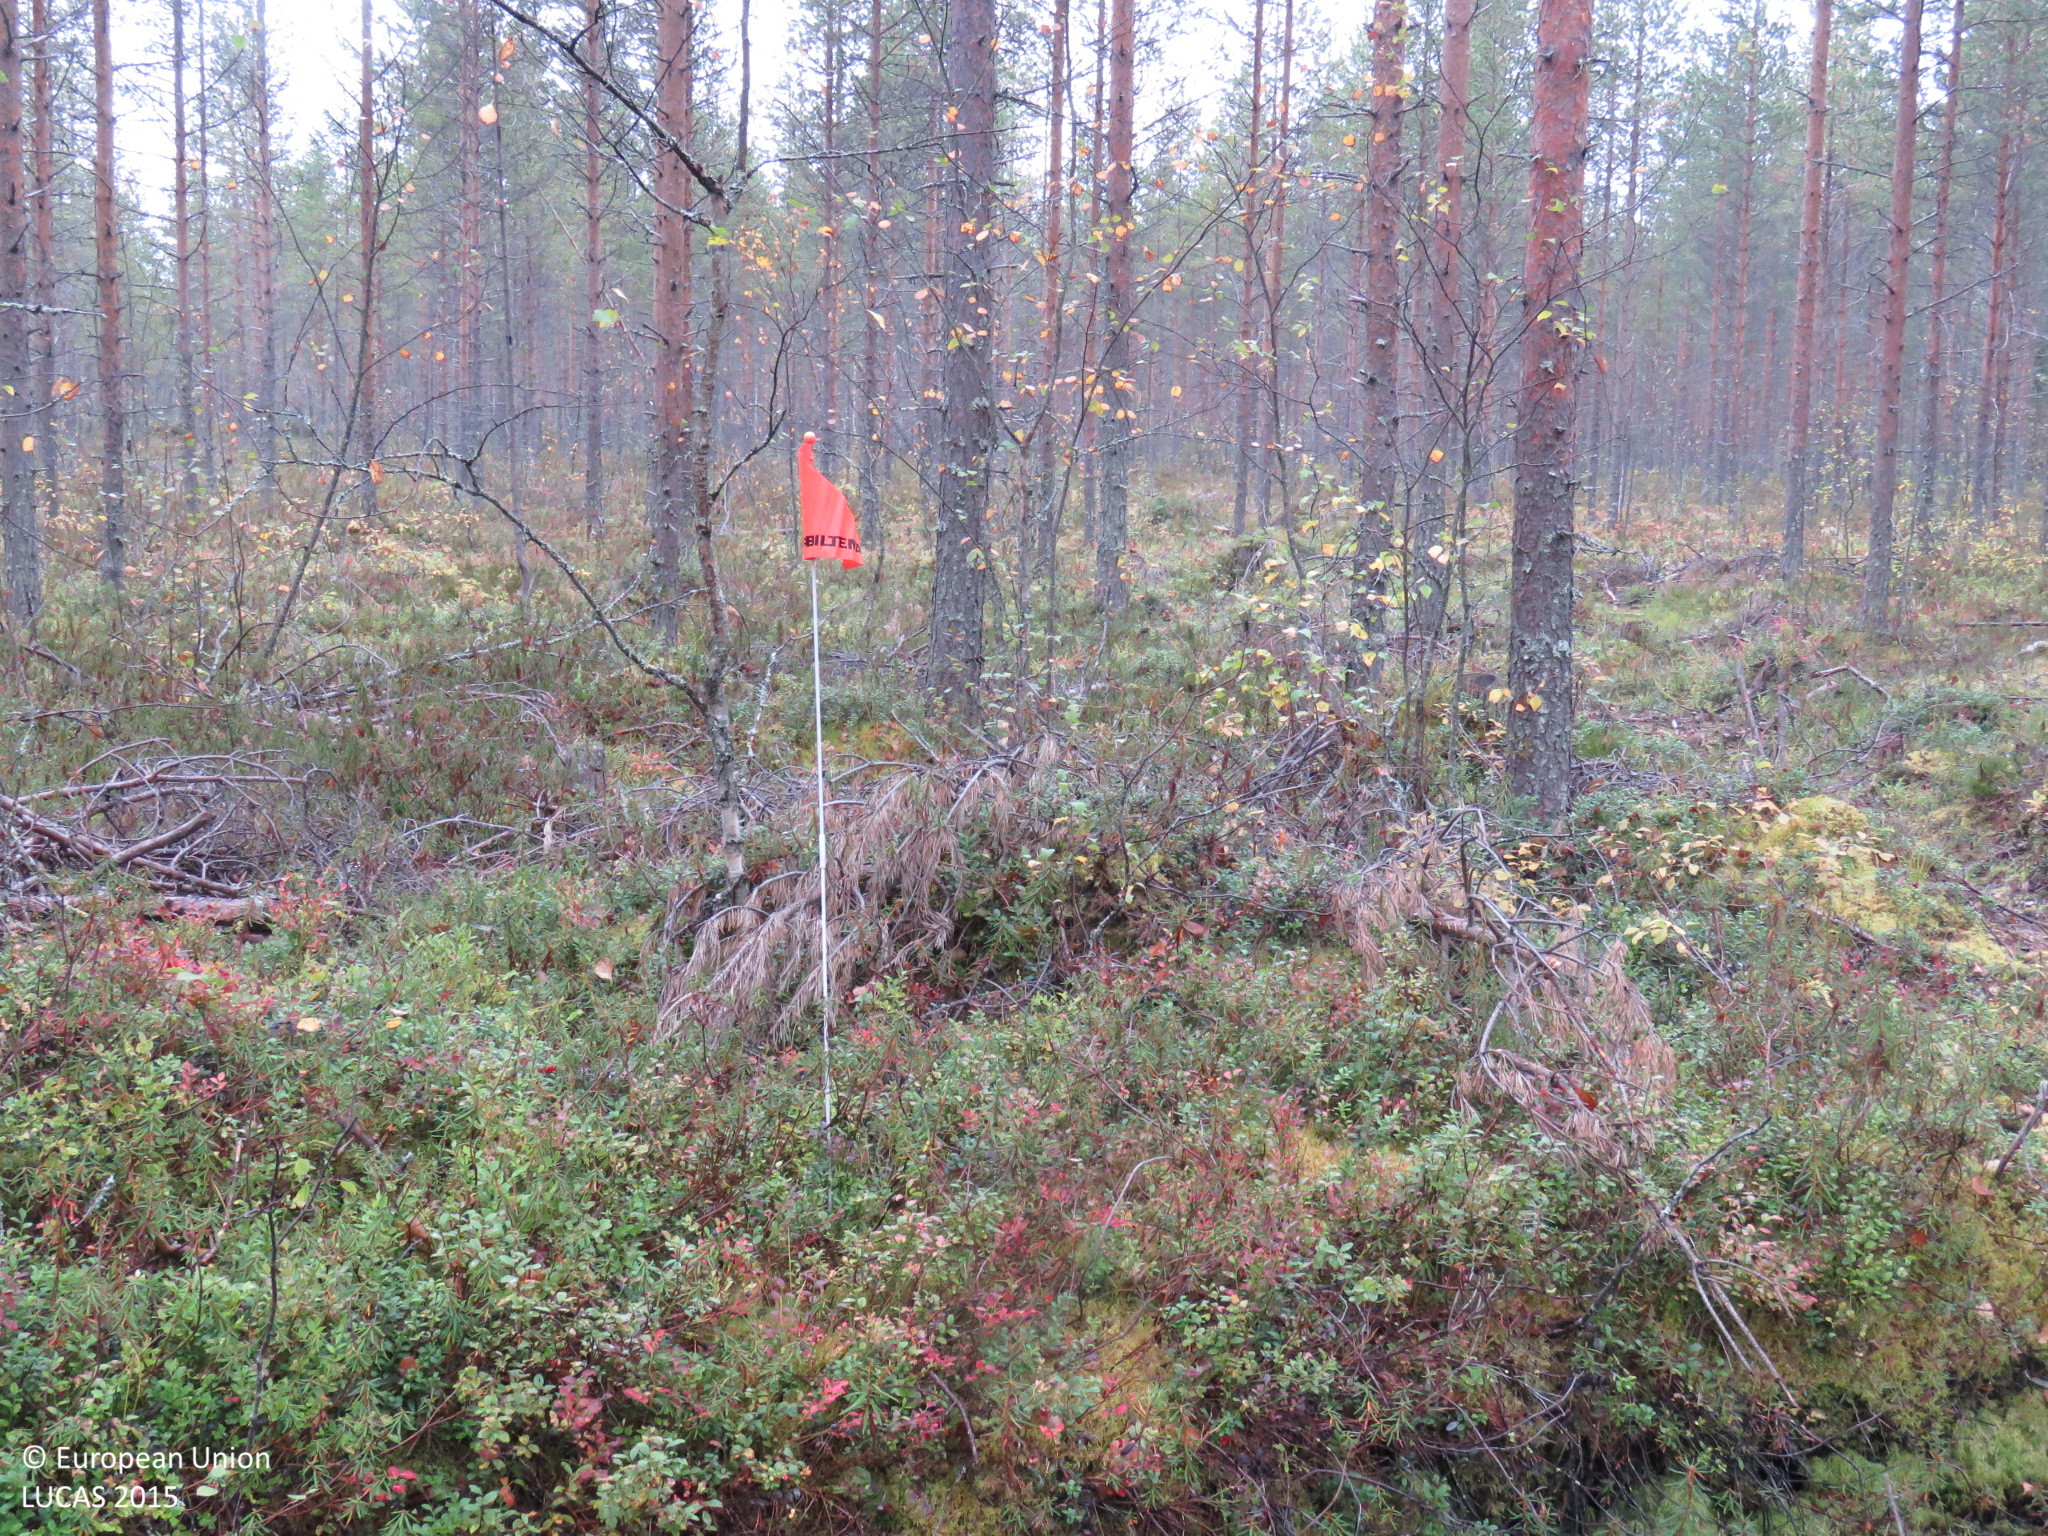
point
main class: Woodland
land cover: Pine dominated coniferous woodland
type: boreal forest
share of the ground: 50 - 75 %
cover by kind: coniferous forest trees 65 %, shrubs 20 %, lichens and mosses 10 %, broadleaved forest trees 5 %
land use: Forestry
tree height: > 5 m
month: September
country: FI
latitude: 64.8482
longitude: 26.9716
